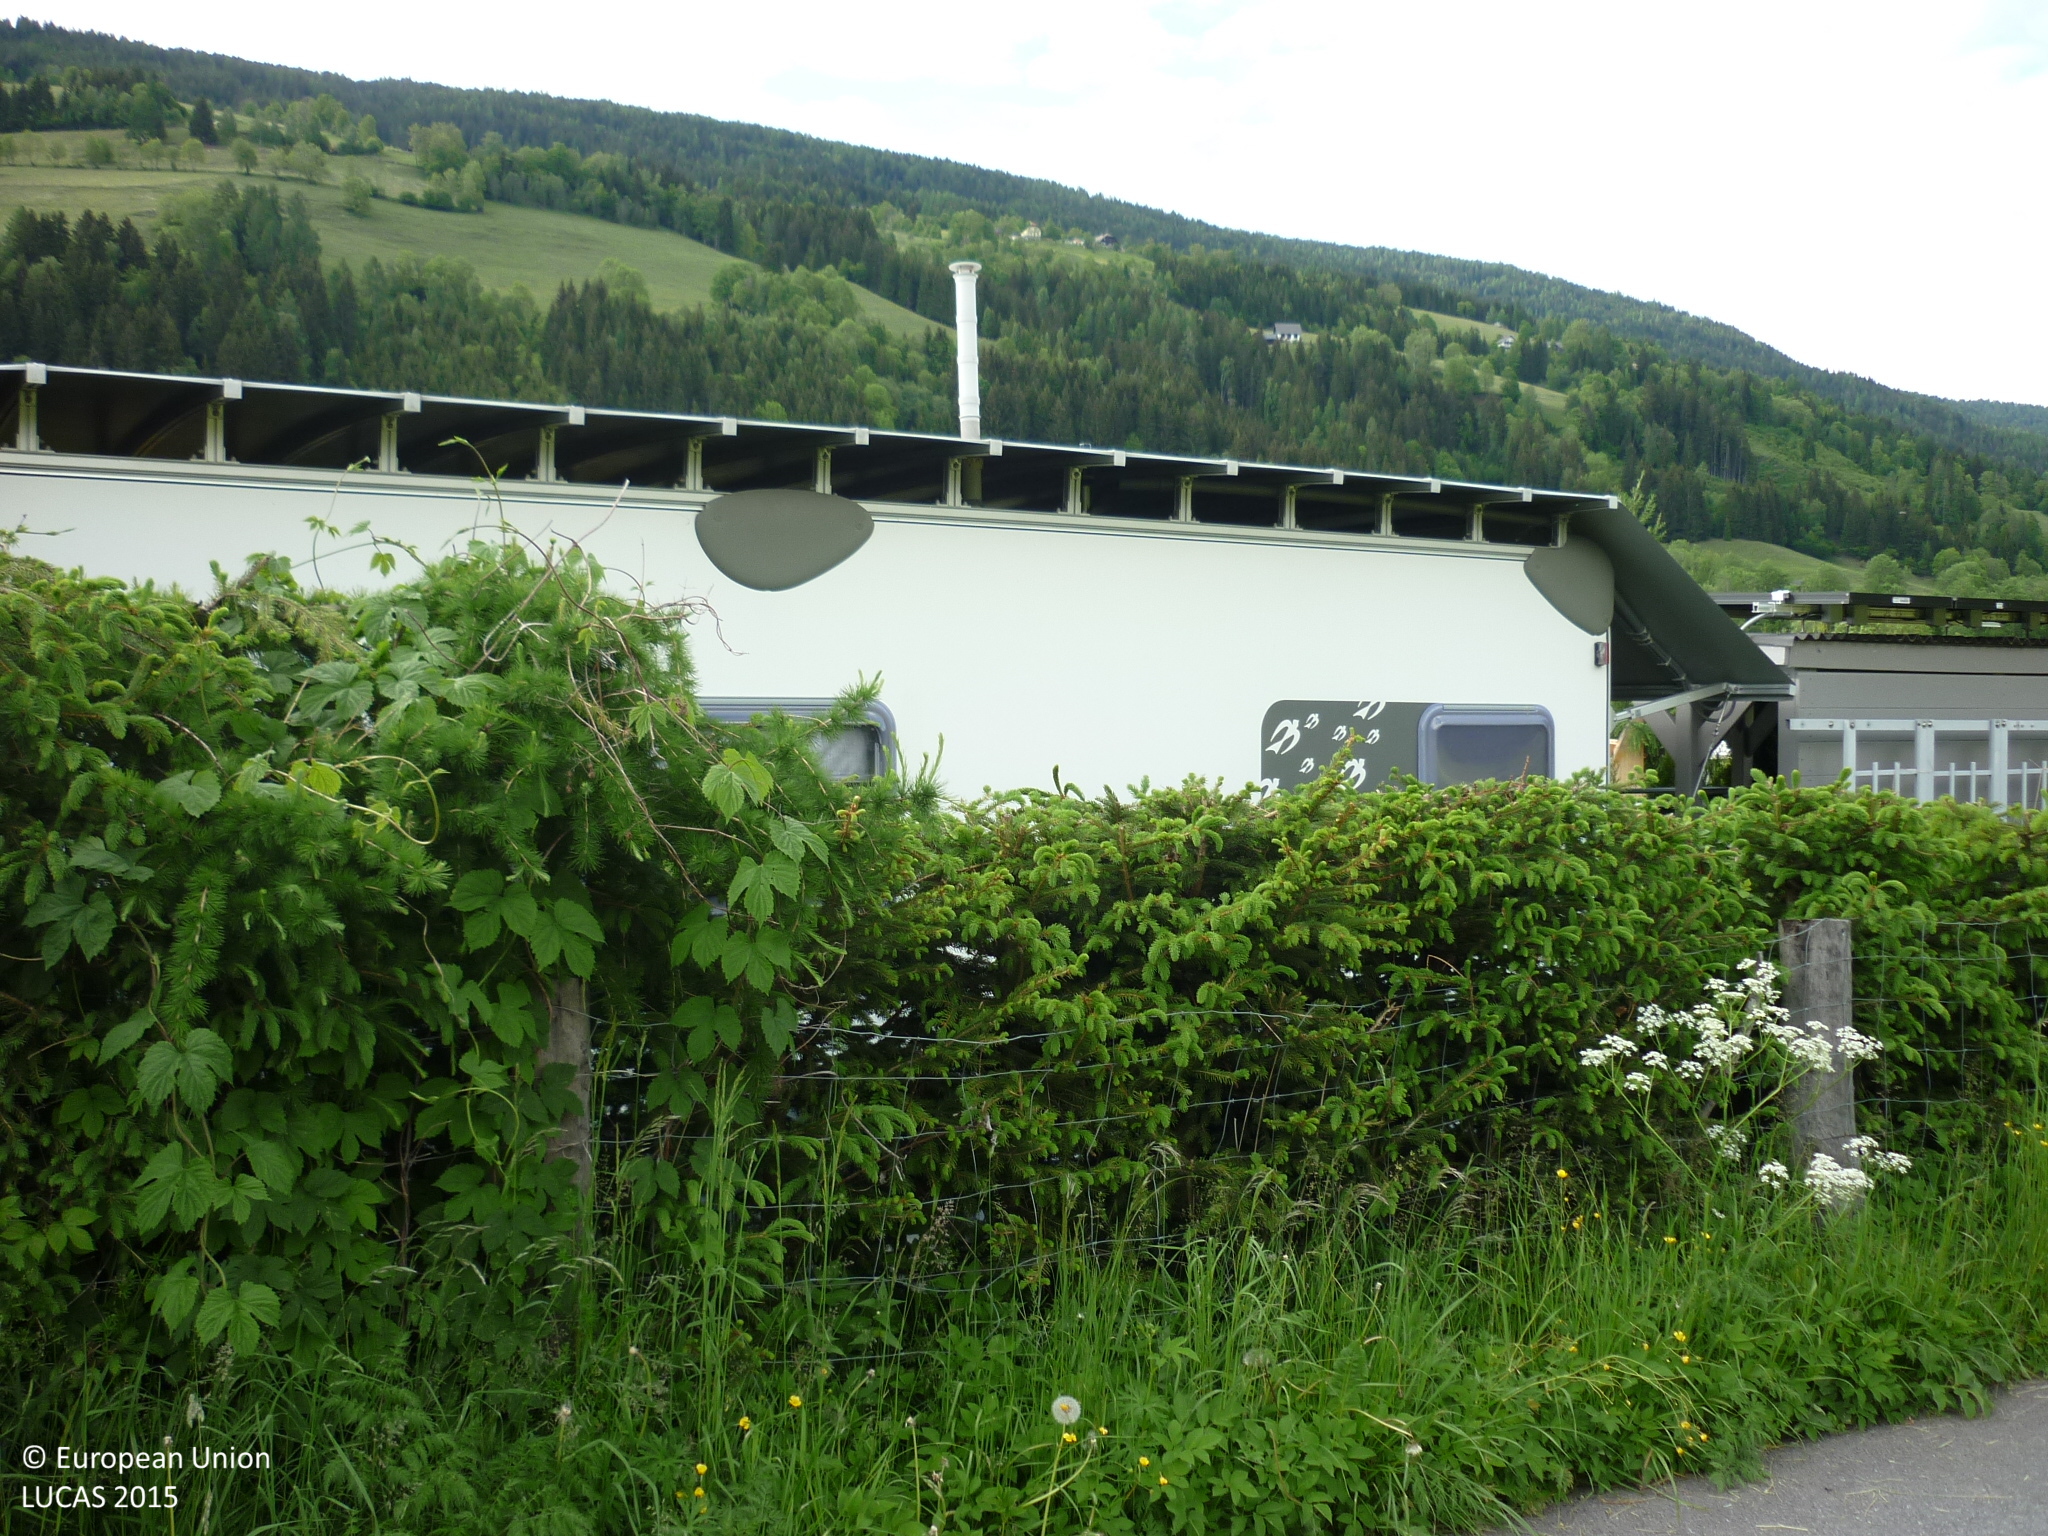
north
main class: Grassland
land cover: Grassland without tree/shrub cover
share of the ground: > 75 %
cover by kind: herbaceous plants 100 %
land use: Agriculture (excluding fallow land and kitchen gardens)
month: May
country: AT
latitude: 47.0881
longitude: 13.9894
